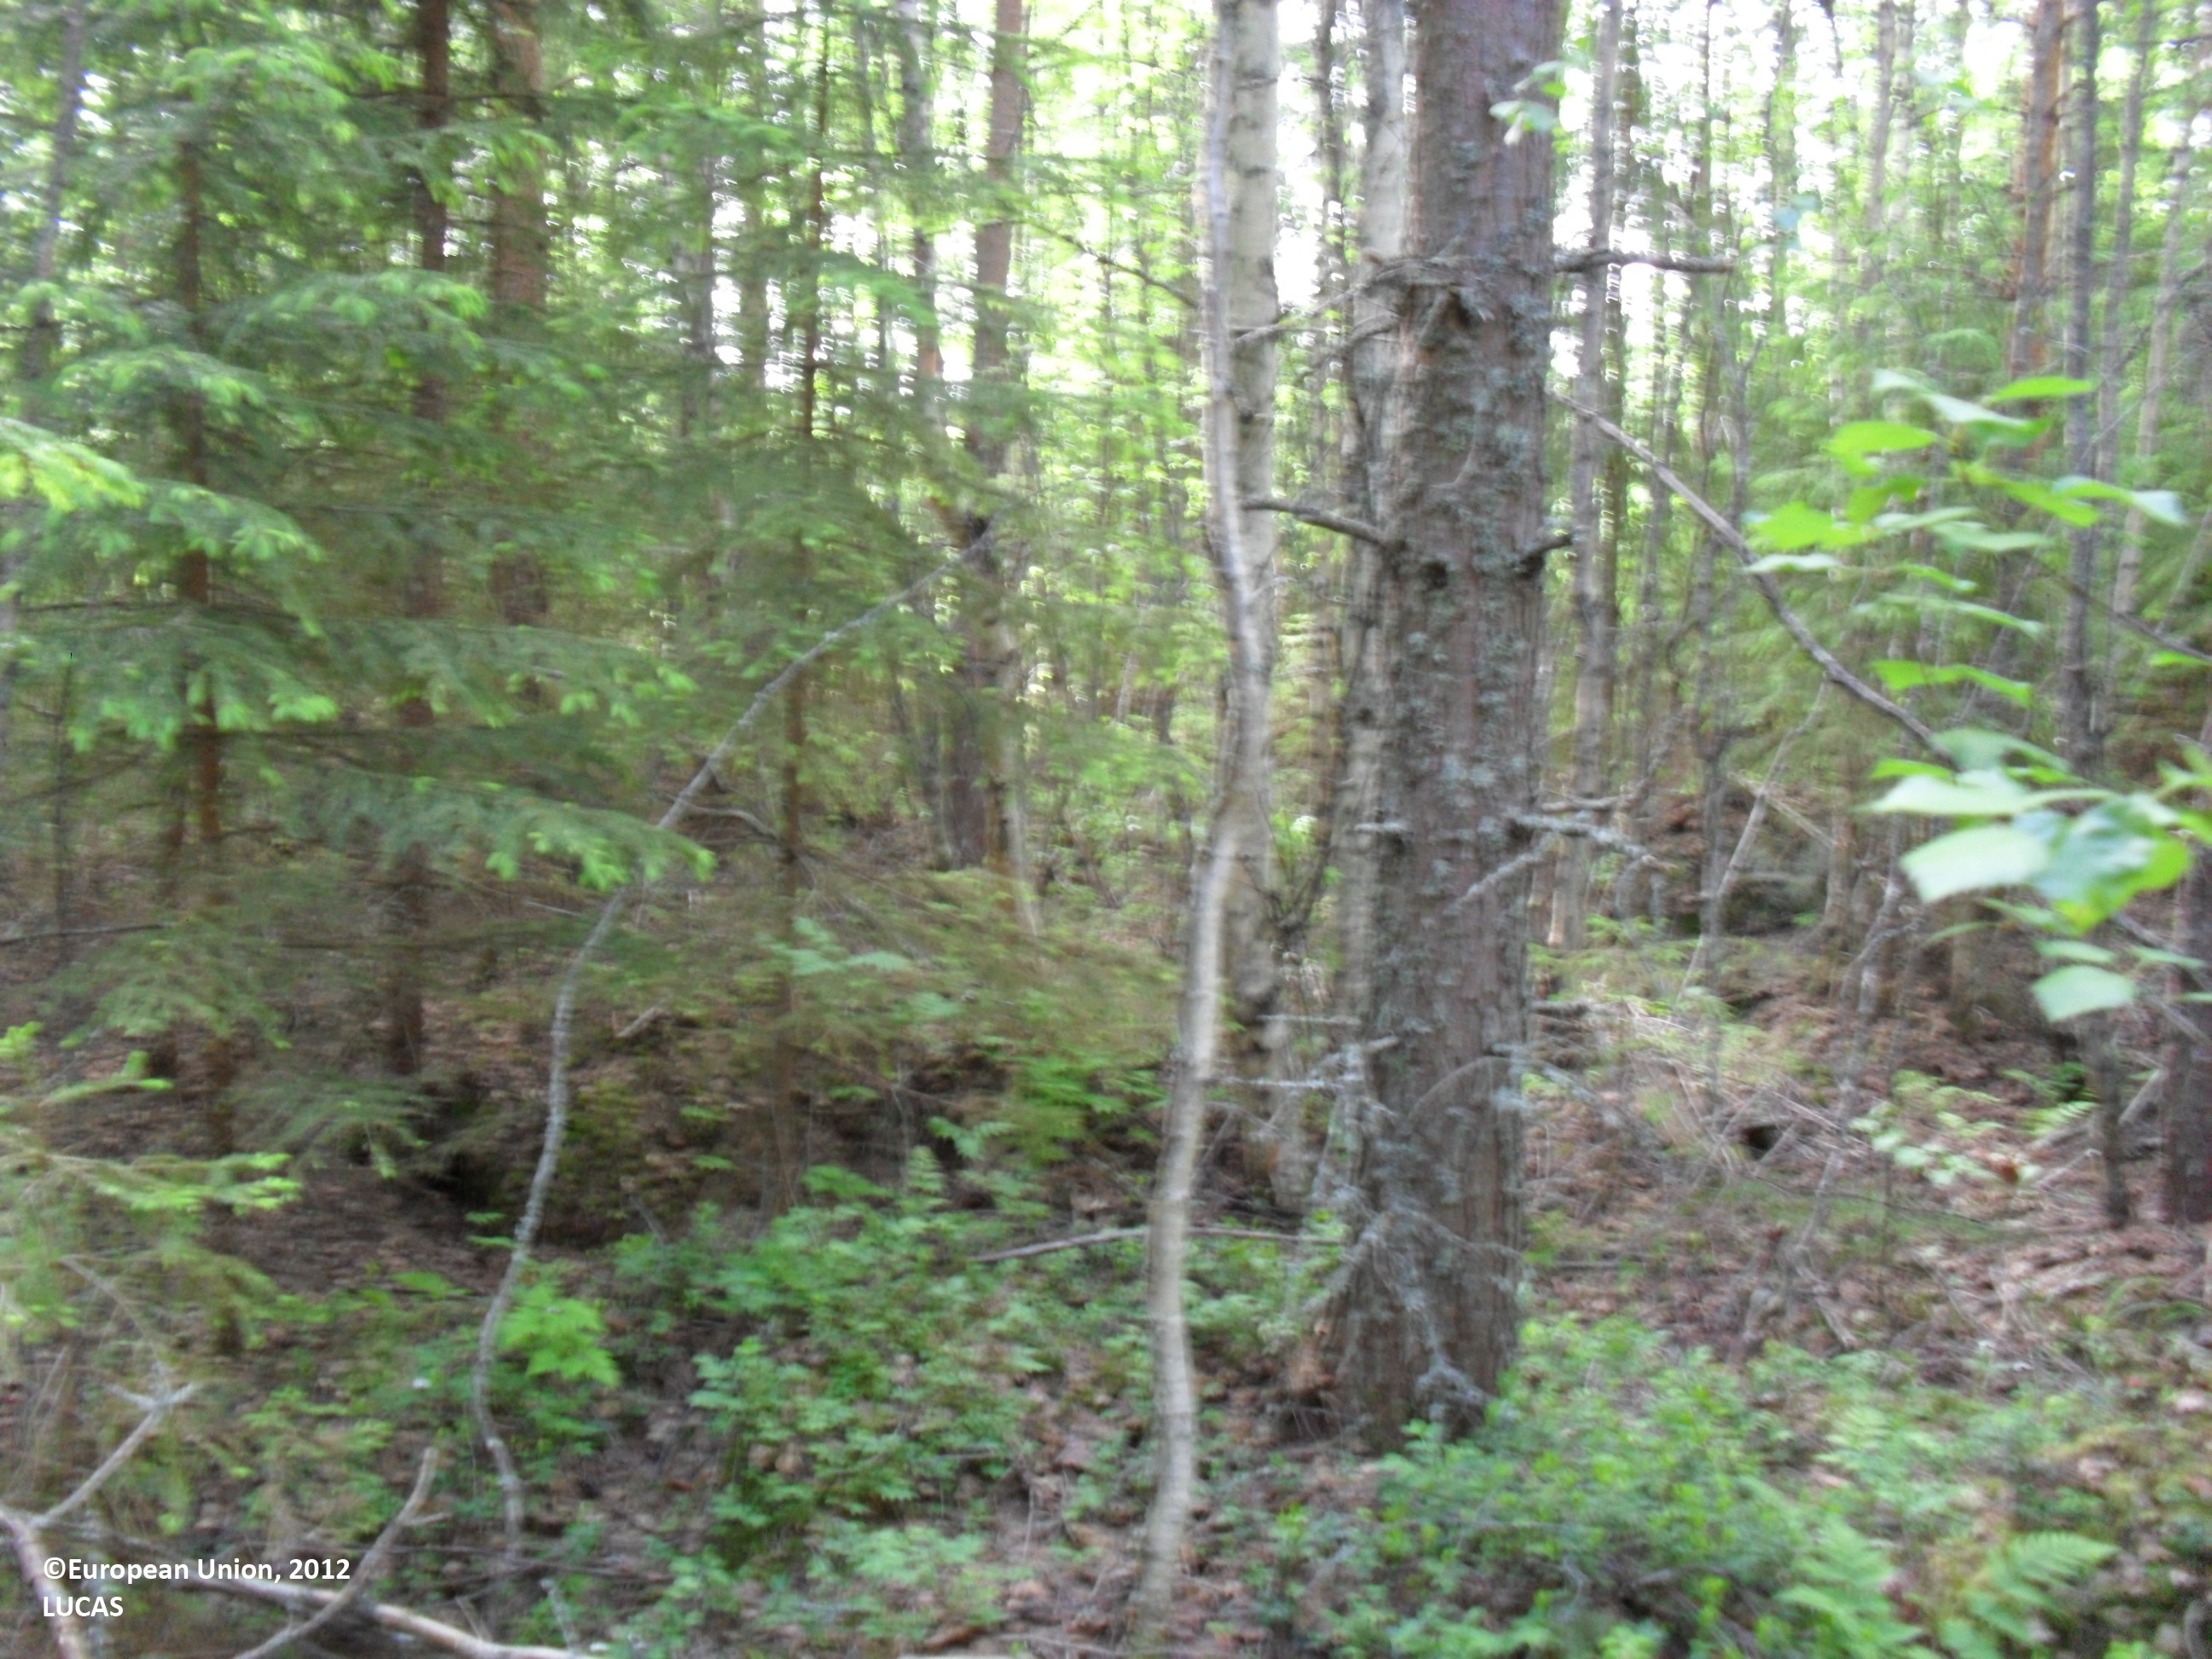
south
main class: Woodland
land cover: Other mixed woodland
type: boreal forest
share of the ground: > 75 %
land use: Forestry
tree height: > 5 m
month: June
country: FI
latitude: 62.7263
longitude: 23.3882
